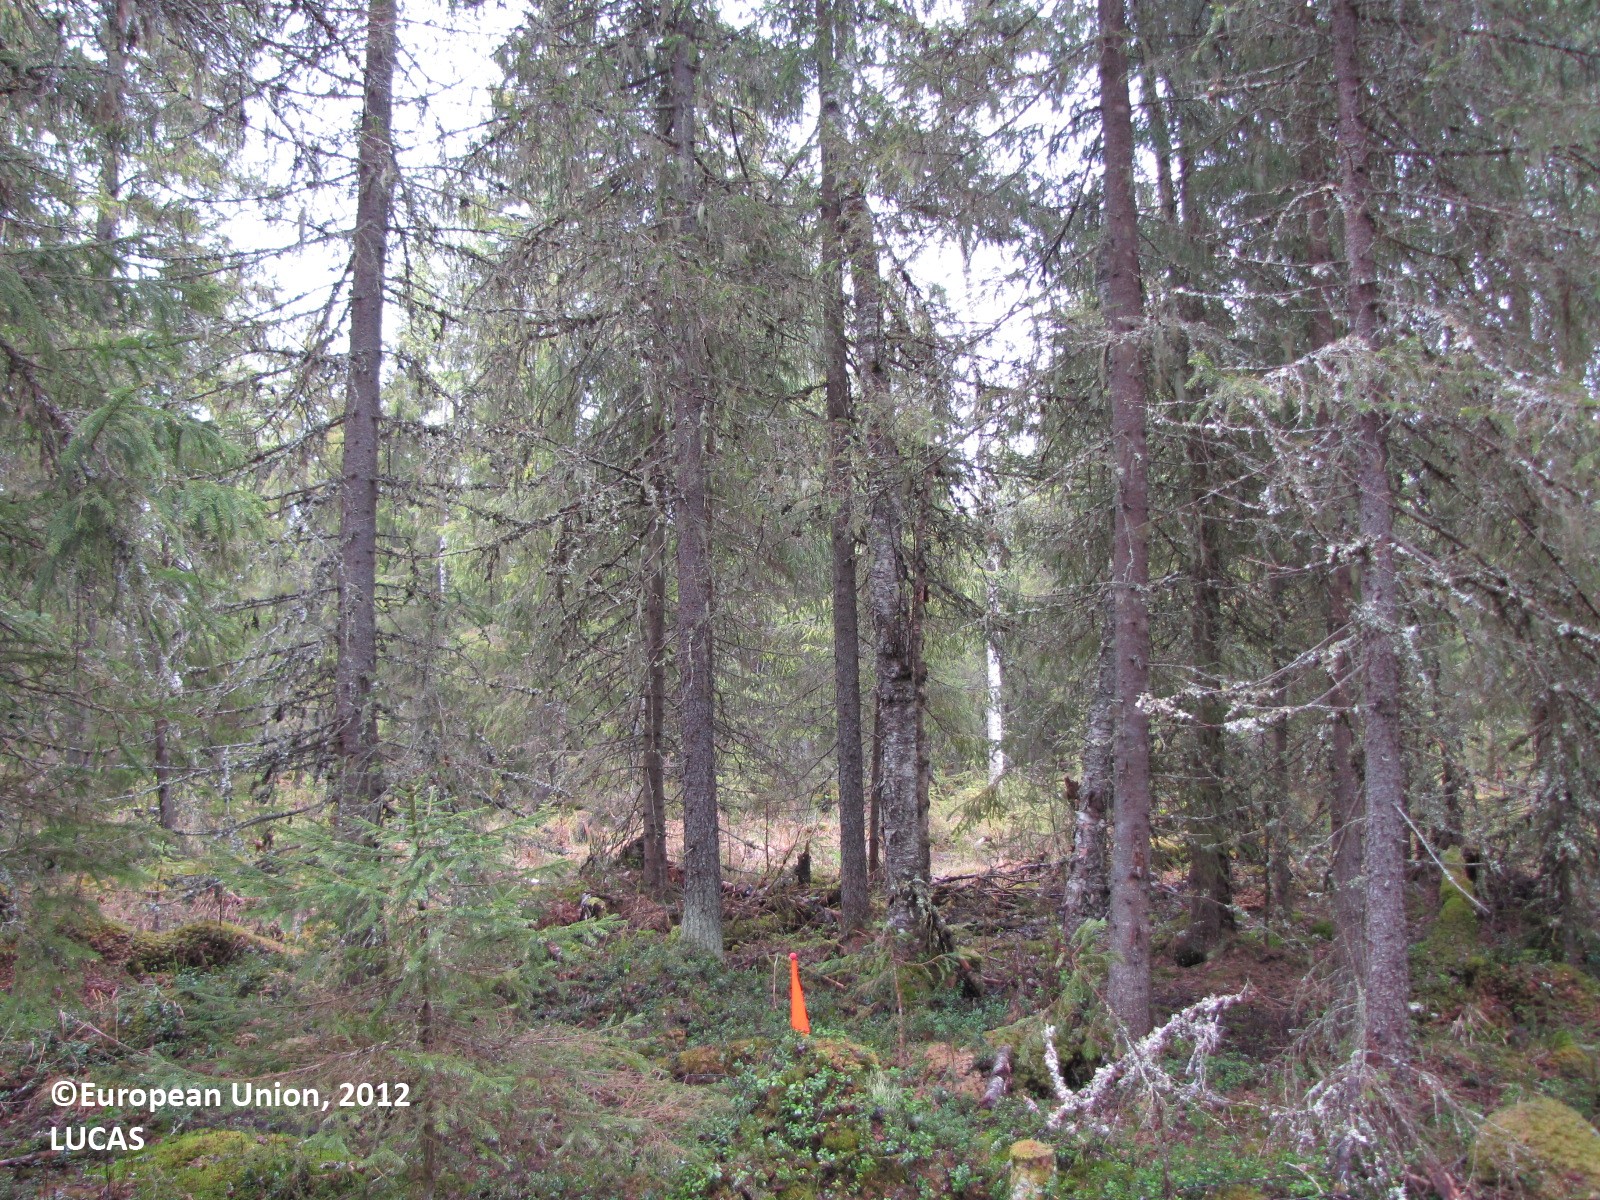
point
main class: Woodland
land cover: Spruce dominated coniferous woodland
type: boreal forest
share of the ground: 50 - 75 %
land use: Forestry
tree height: > 5 m
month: June
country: FI
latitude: 65.9556
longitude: 24.5473
